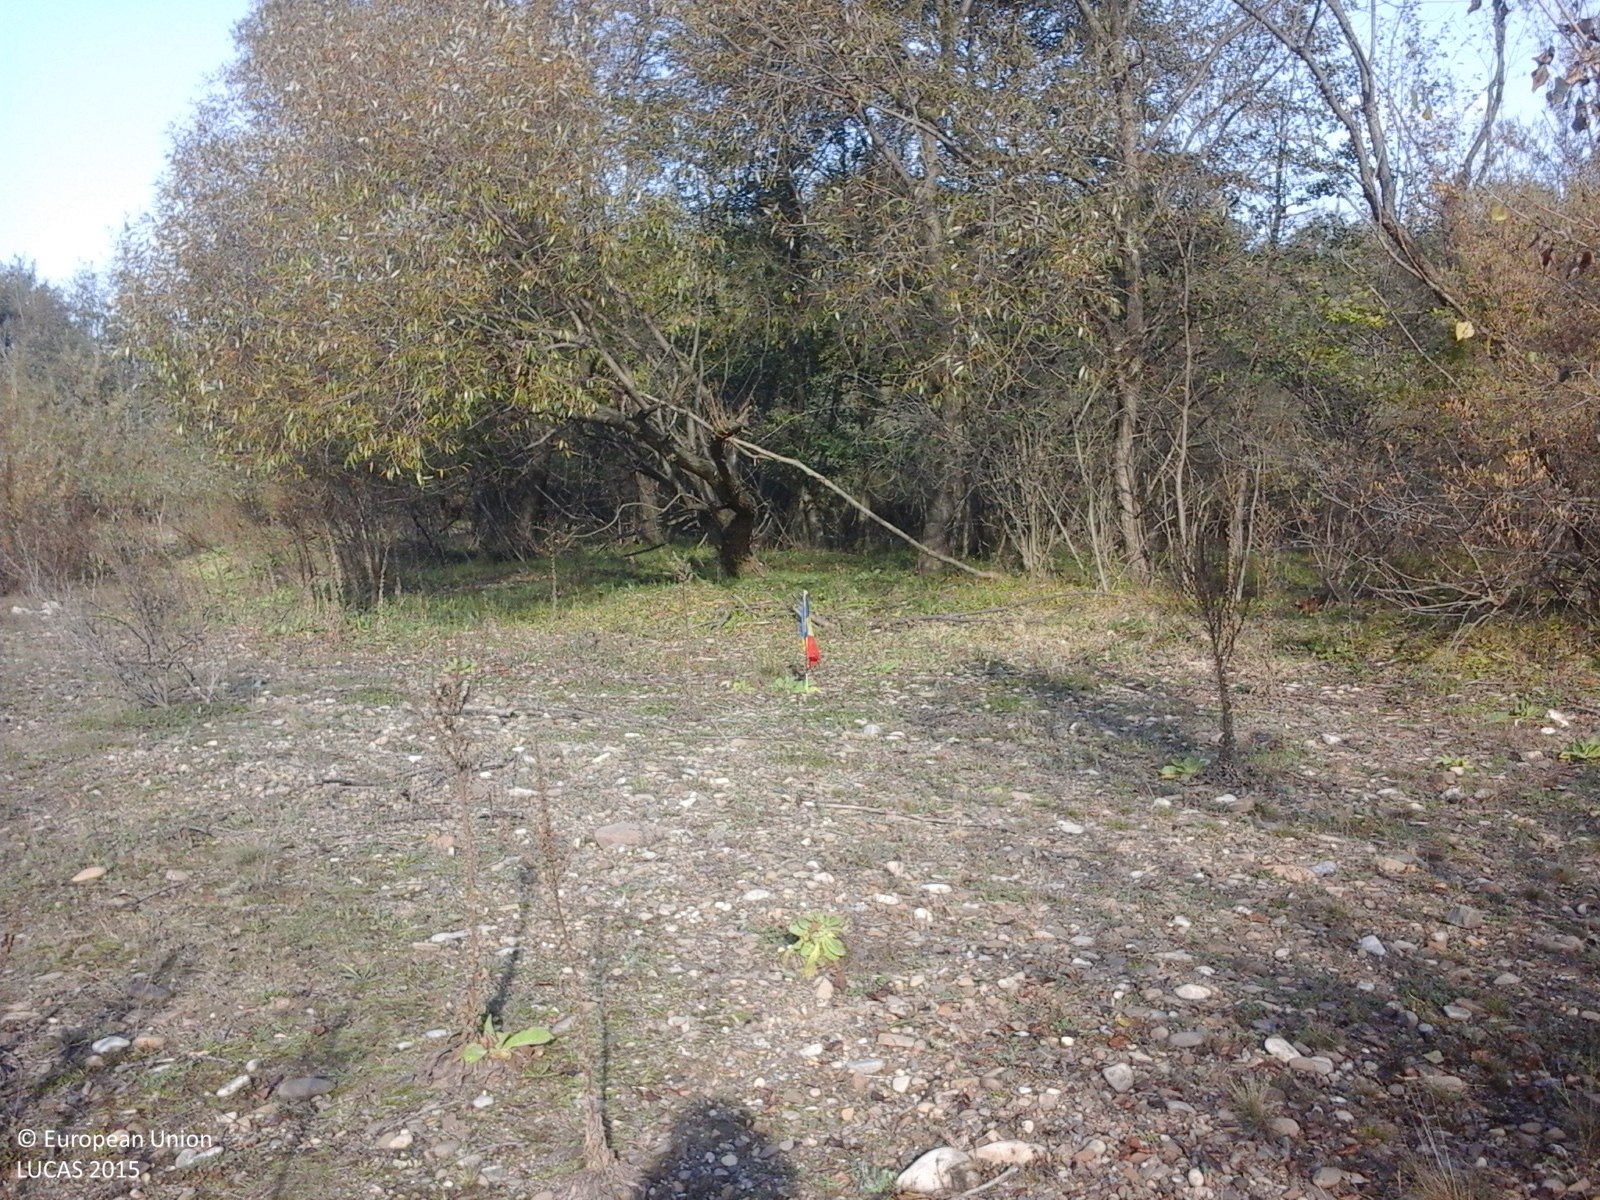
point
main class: Woodland
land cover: Broadleaved woodland
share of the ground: > 75 %
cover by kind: broadleaved forest trees 100 %
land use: Semi-natural and natural areas not in use
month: October
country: RO
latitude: 45.9811
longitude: 26.9351
